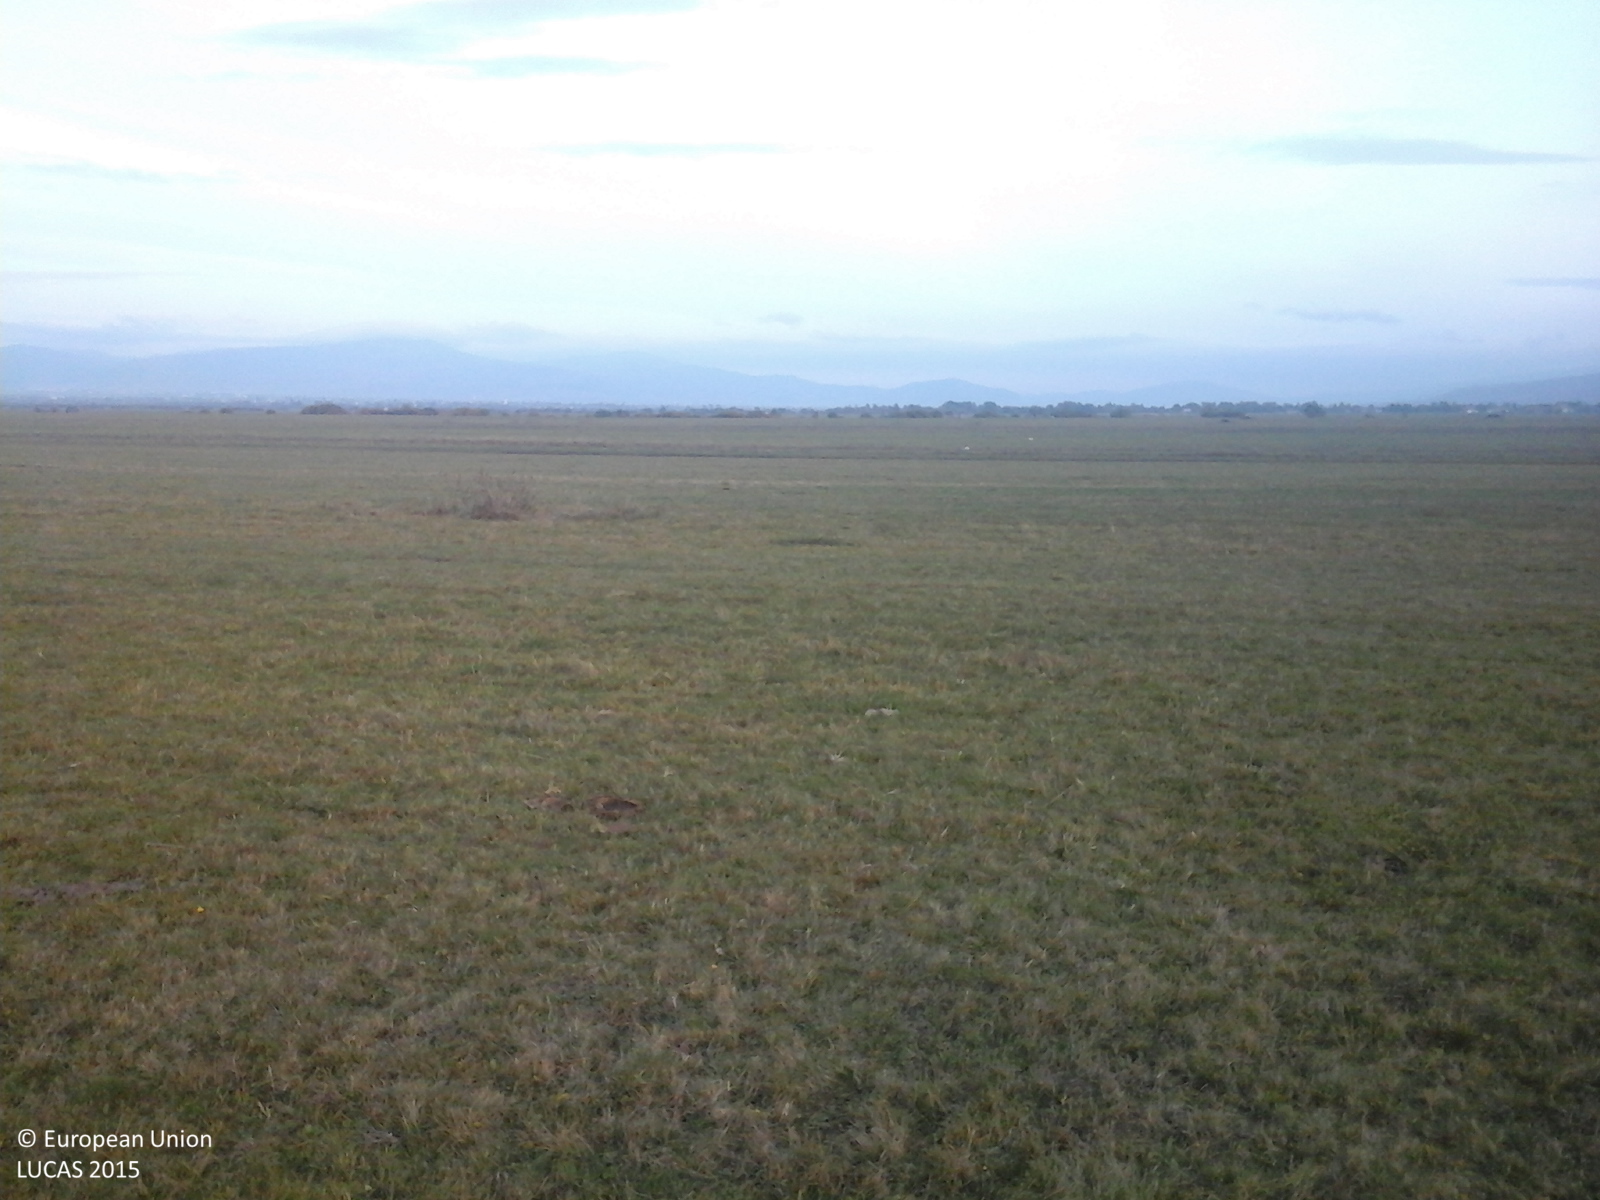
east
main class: Grassland
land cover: Grassland without tree/shrub cover
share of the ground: > 75 %
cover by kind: herbaceous plants 100 %
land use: Agriculture (excluding fallow land and kitchen gardens)
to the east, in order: Grassland without tree/shrub cover; Tracks; Grassland without tree/shrub cover
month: October
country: RO
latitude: 46.7079
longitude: 25.4255
